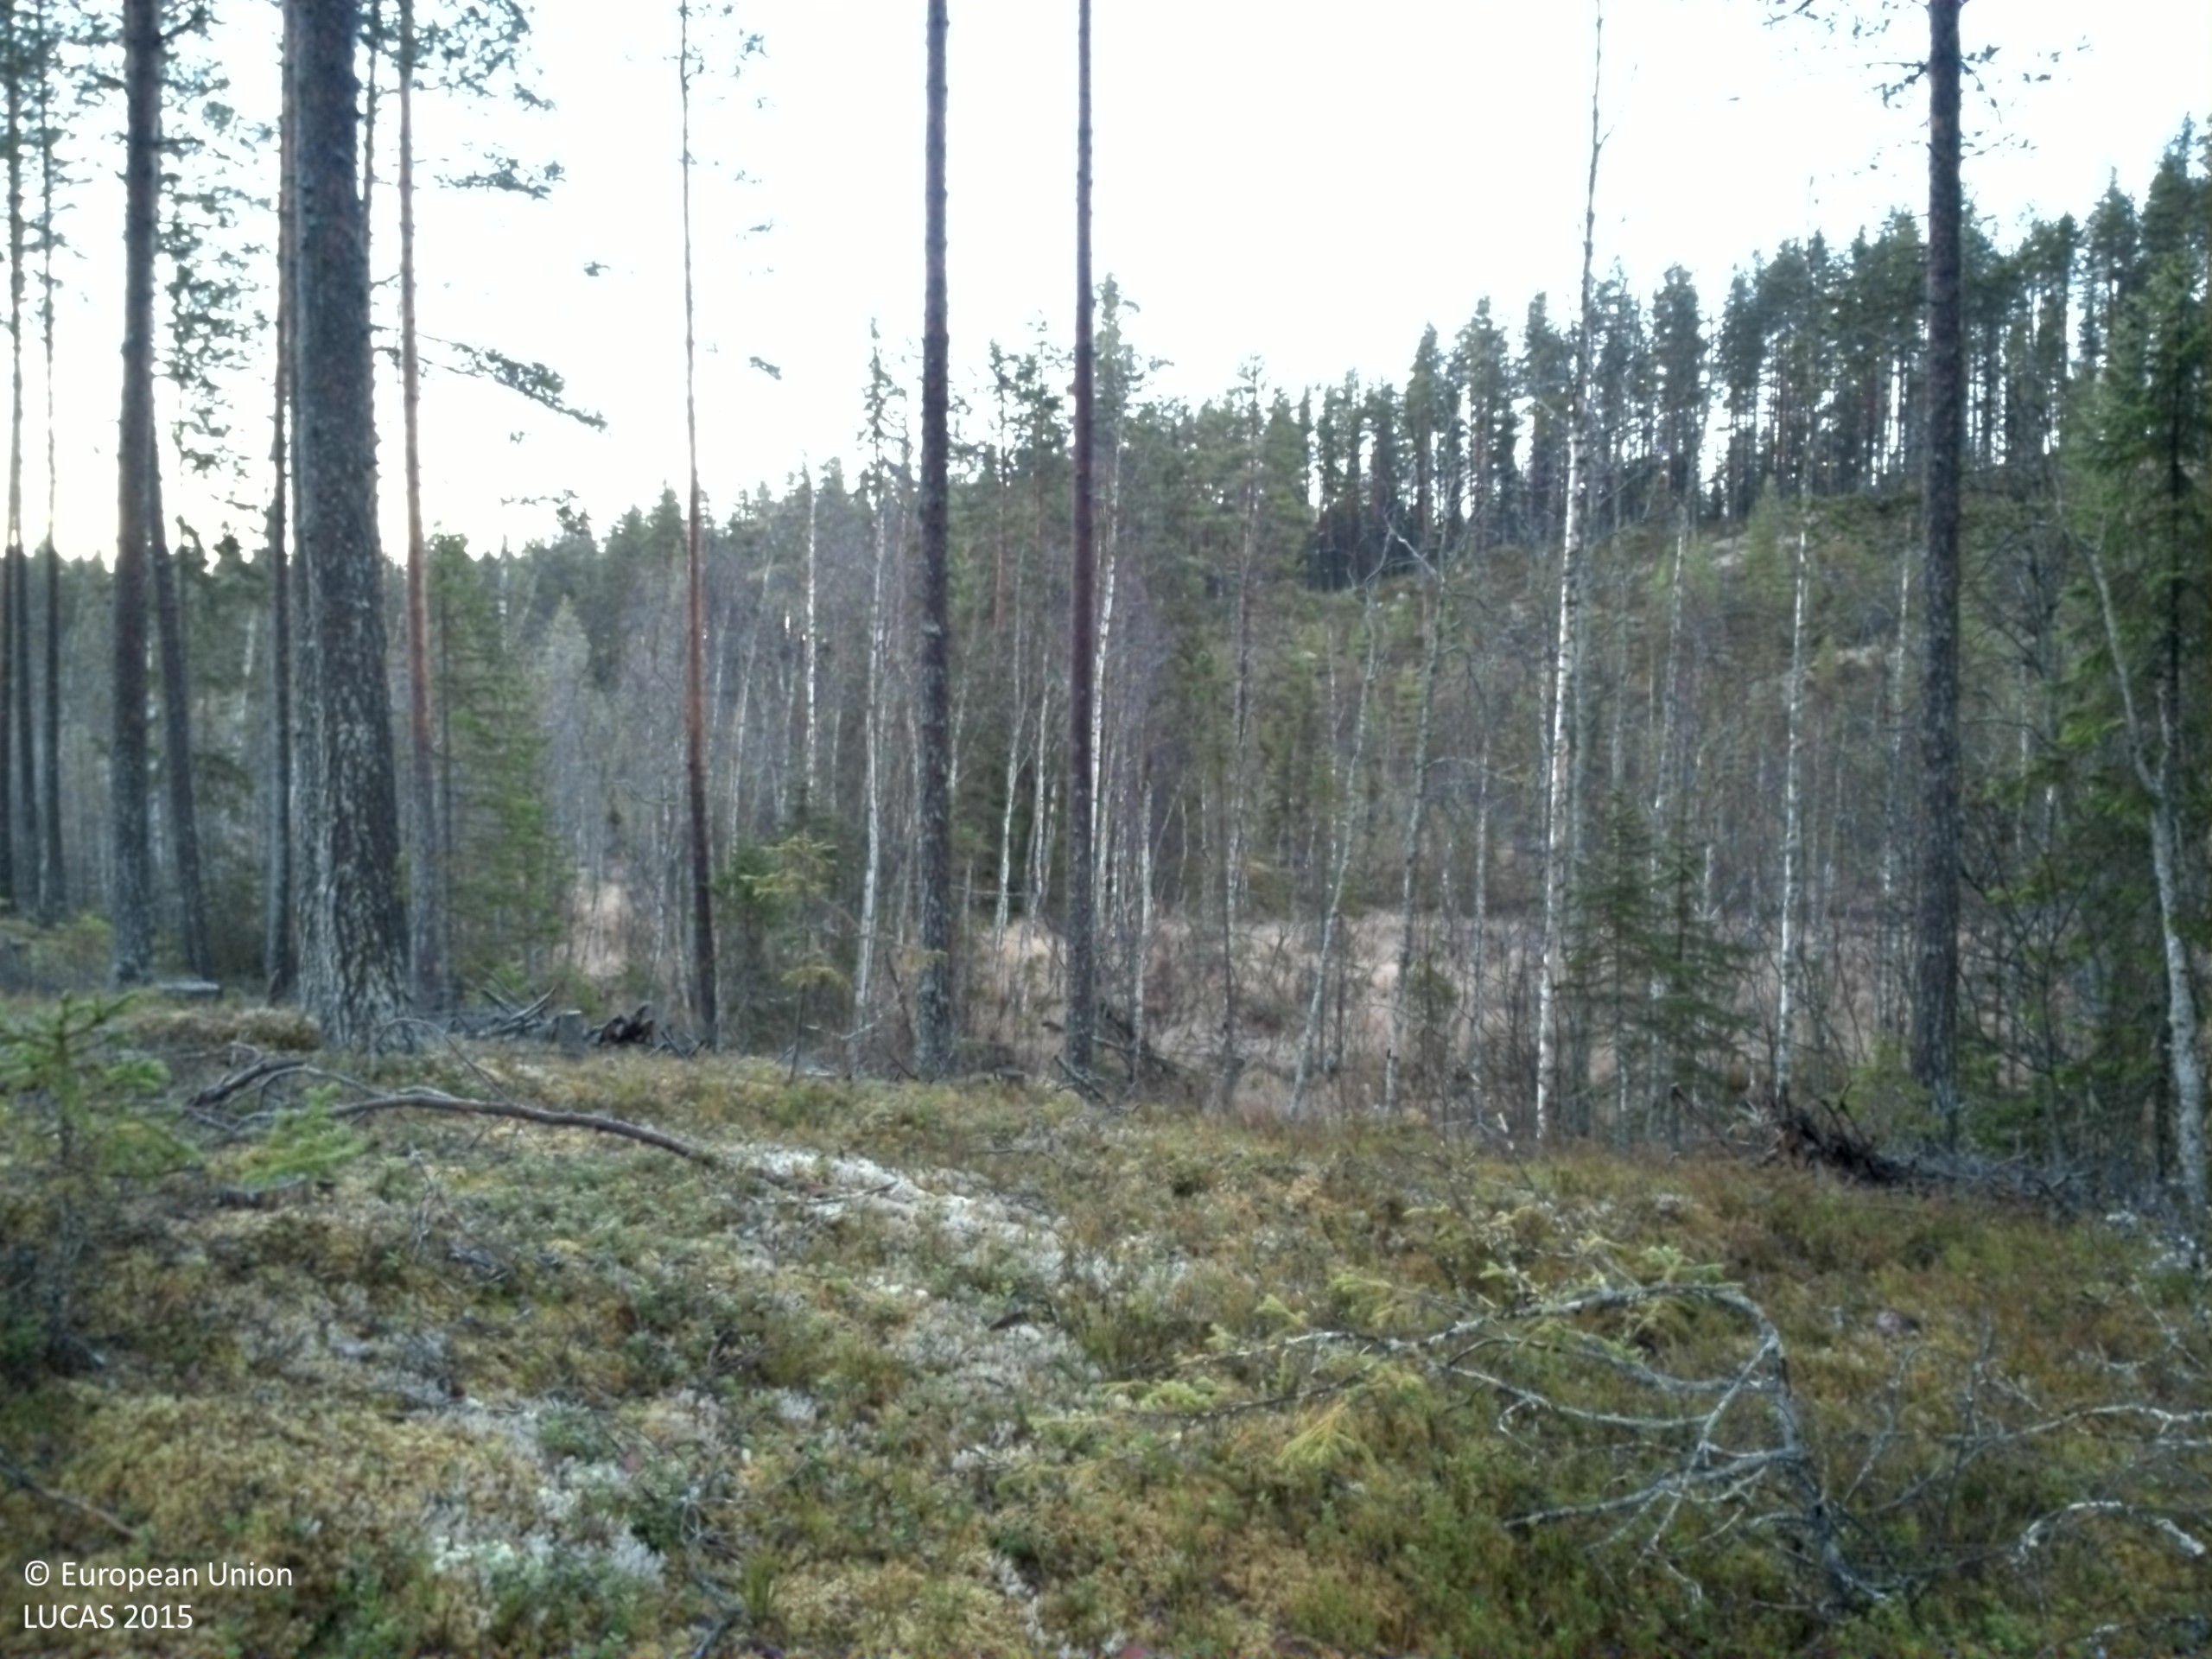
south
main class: Woodland
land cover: Pine dominated coniferous woodland
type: boreal forest
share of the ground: 25 - 50 %
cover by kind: shrubs 50 %, coniferous forest trees 25 %, lichens and mosses 20 %, broadleaved forest trees 5 %
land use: Forestry
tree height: > 5 m
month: November
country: SE
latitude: 63.8940
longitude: 16.2657
